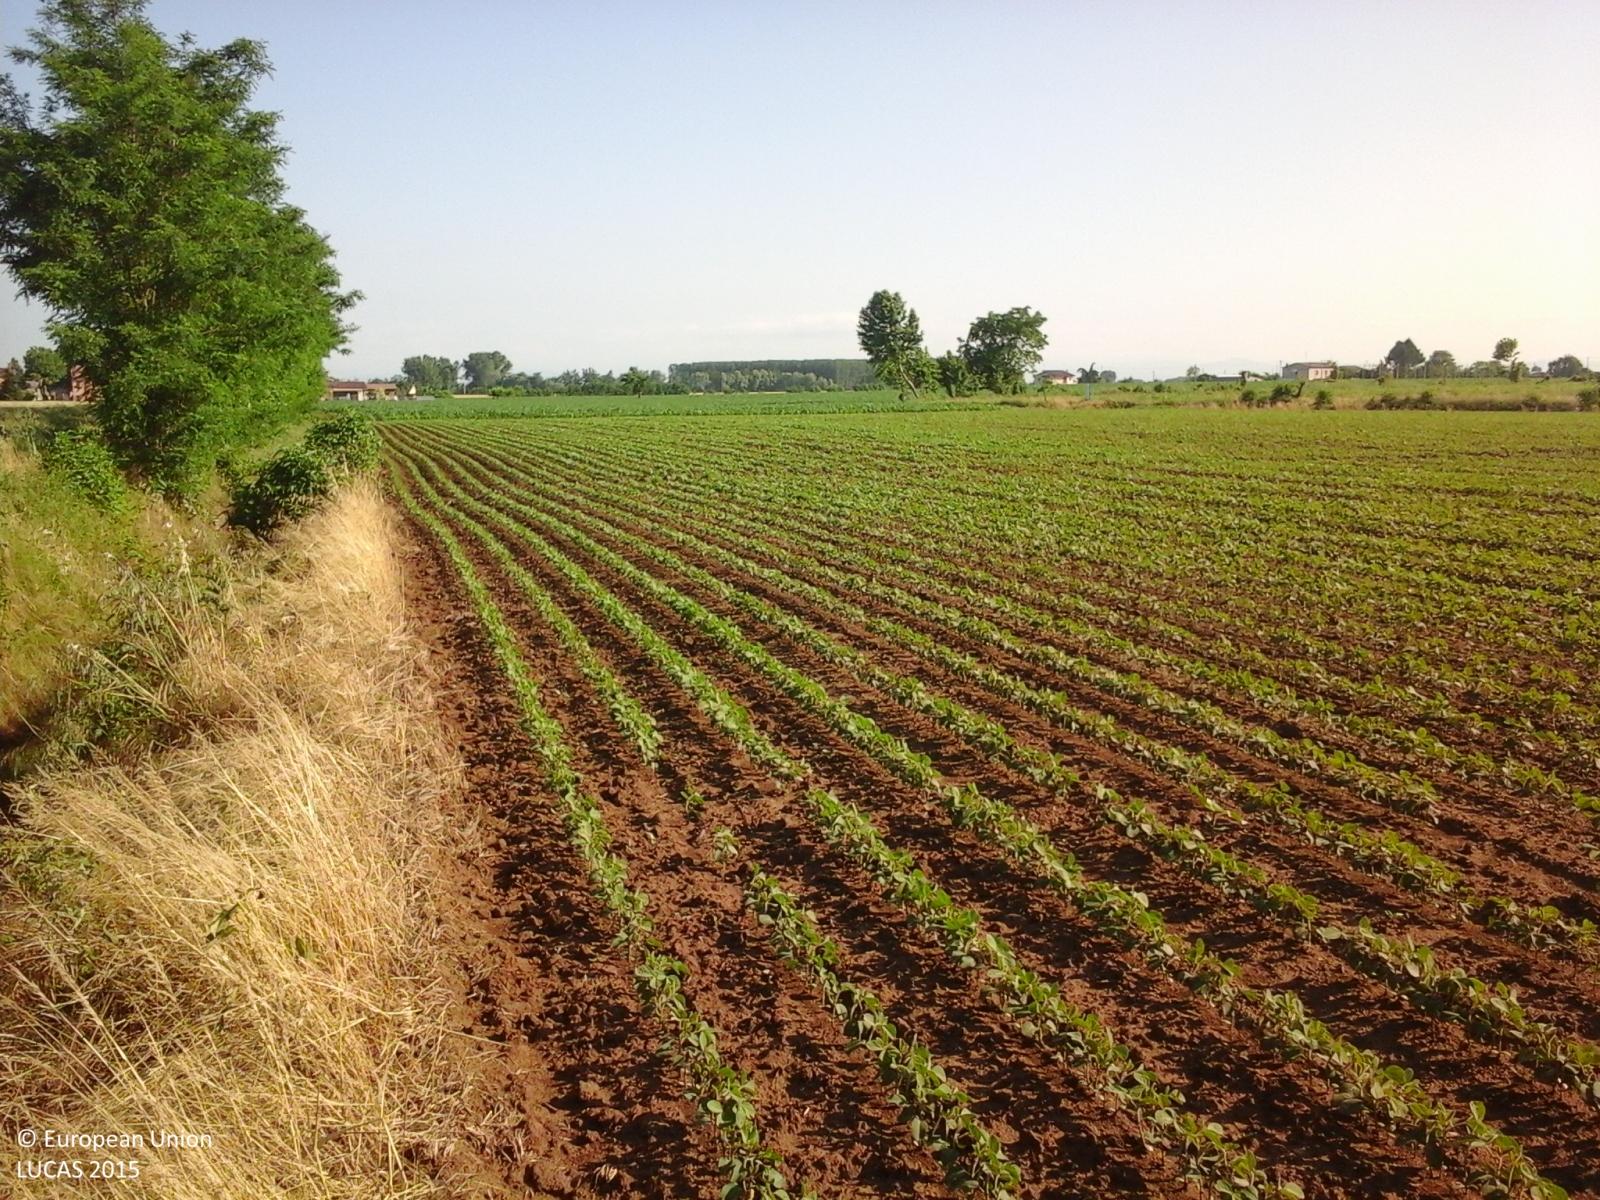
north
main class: Cropland
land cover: Common wheat
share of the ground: > 75 %
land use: Agriculture (excluding fallow land and kitchen gardens)
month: May
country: IT
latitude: 45.1930
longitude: 11.0291
